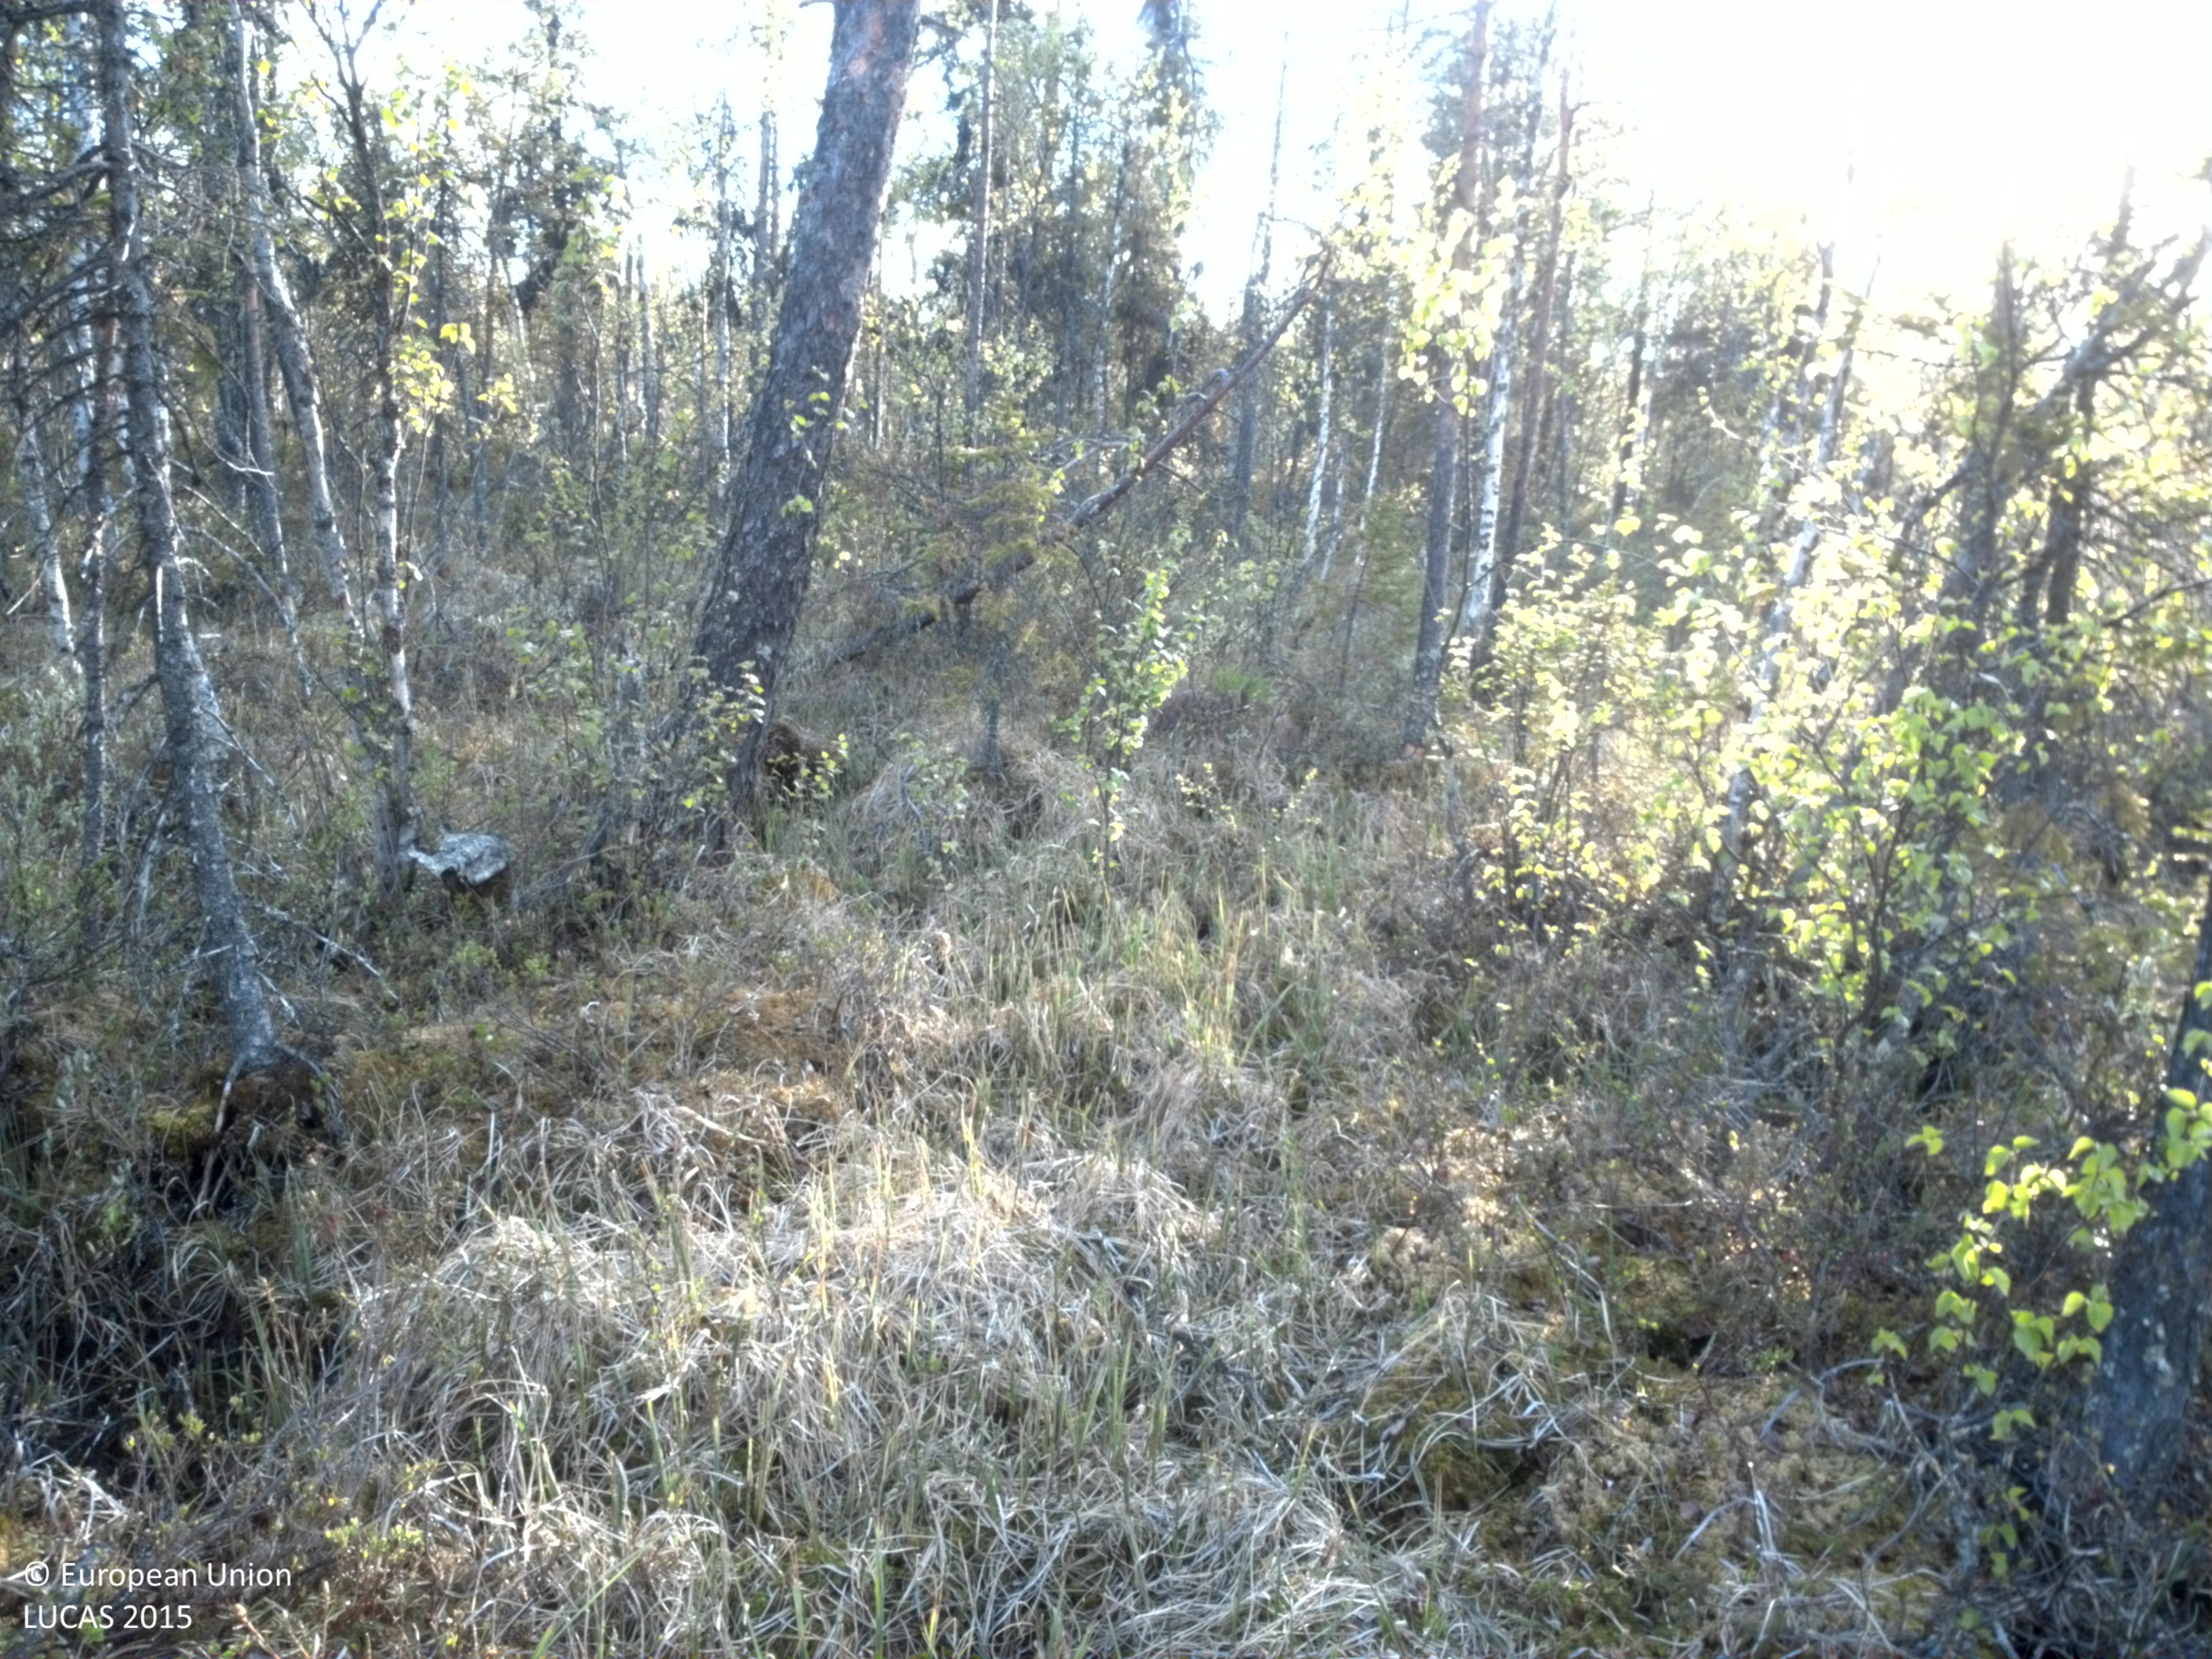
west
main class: Woodland
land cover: Pine dominated mixed woodland
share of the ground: 10 - 25 %
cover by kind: shrubs 50 %, herbaceous plants 20 %, coniferous forest trees 15 %, lichens and mosses 10 %, broadleaved forest trees 5 %
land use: Semi-natural and natural areas not in use
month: June
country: SE
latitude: 66.8826
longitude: 21.6220
